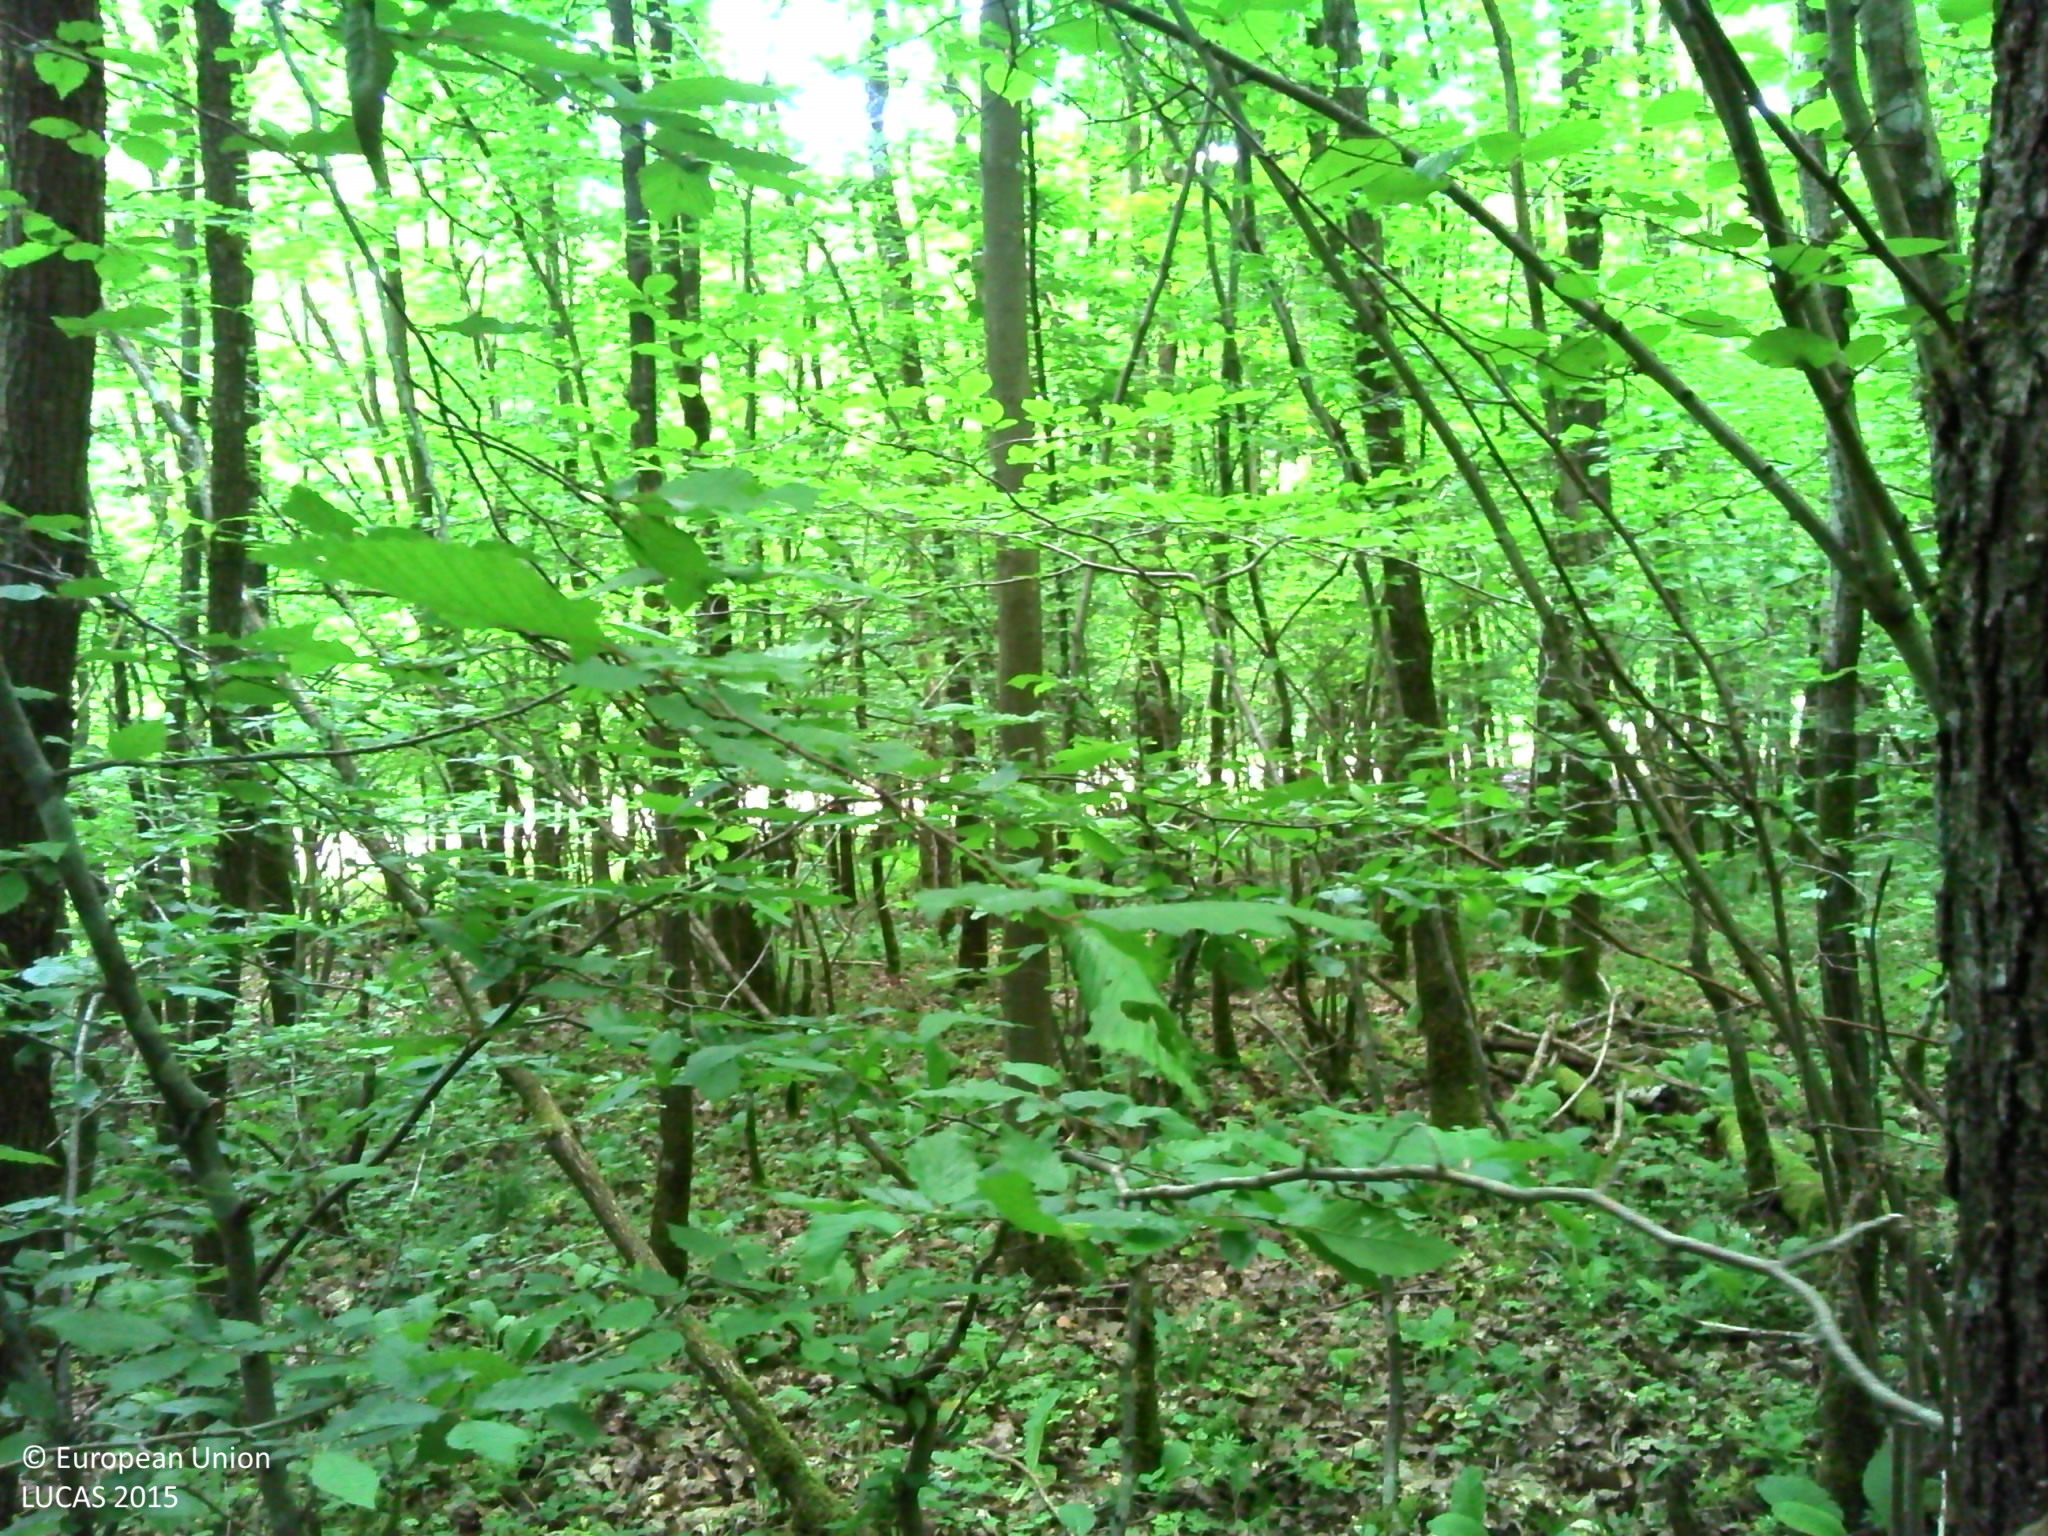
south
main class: Woodland
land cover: Broadleaved woodland
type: mesophytic deciduous forest
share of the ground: > 75 %
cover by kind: broadleaved forest trees 90 %, herbaceous plants 5 %, lichens and mosses 5 %
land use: Forestry
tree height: > 5 m
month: May
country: LU
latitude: 49.6769
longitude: 6.3827
